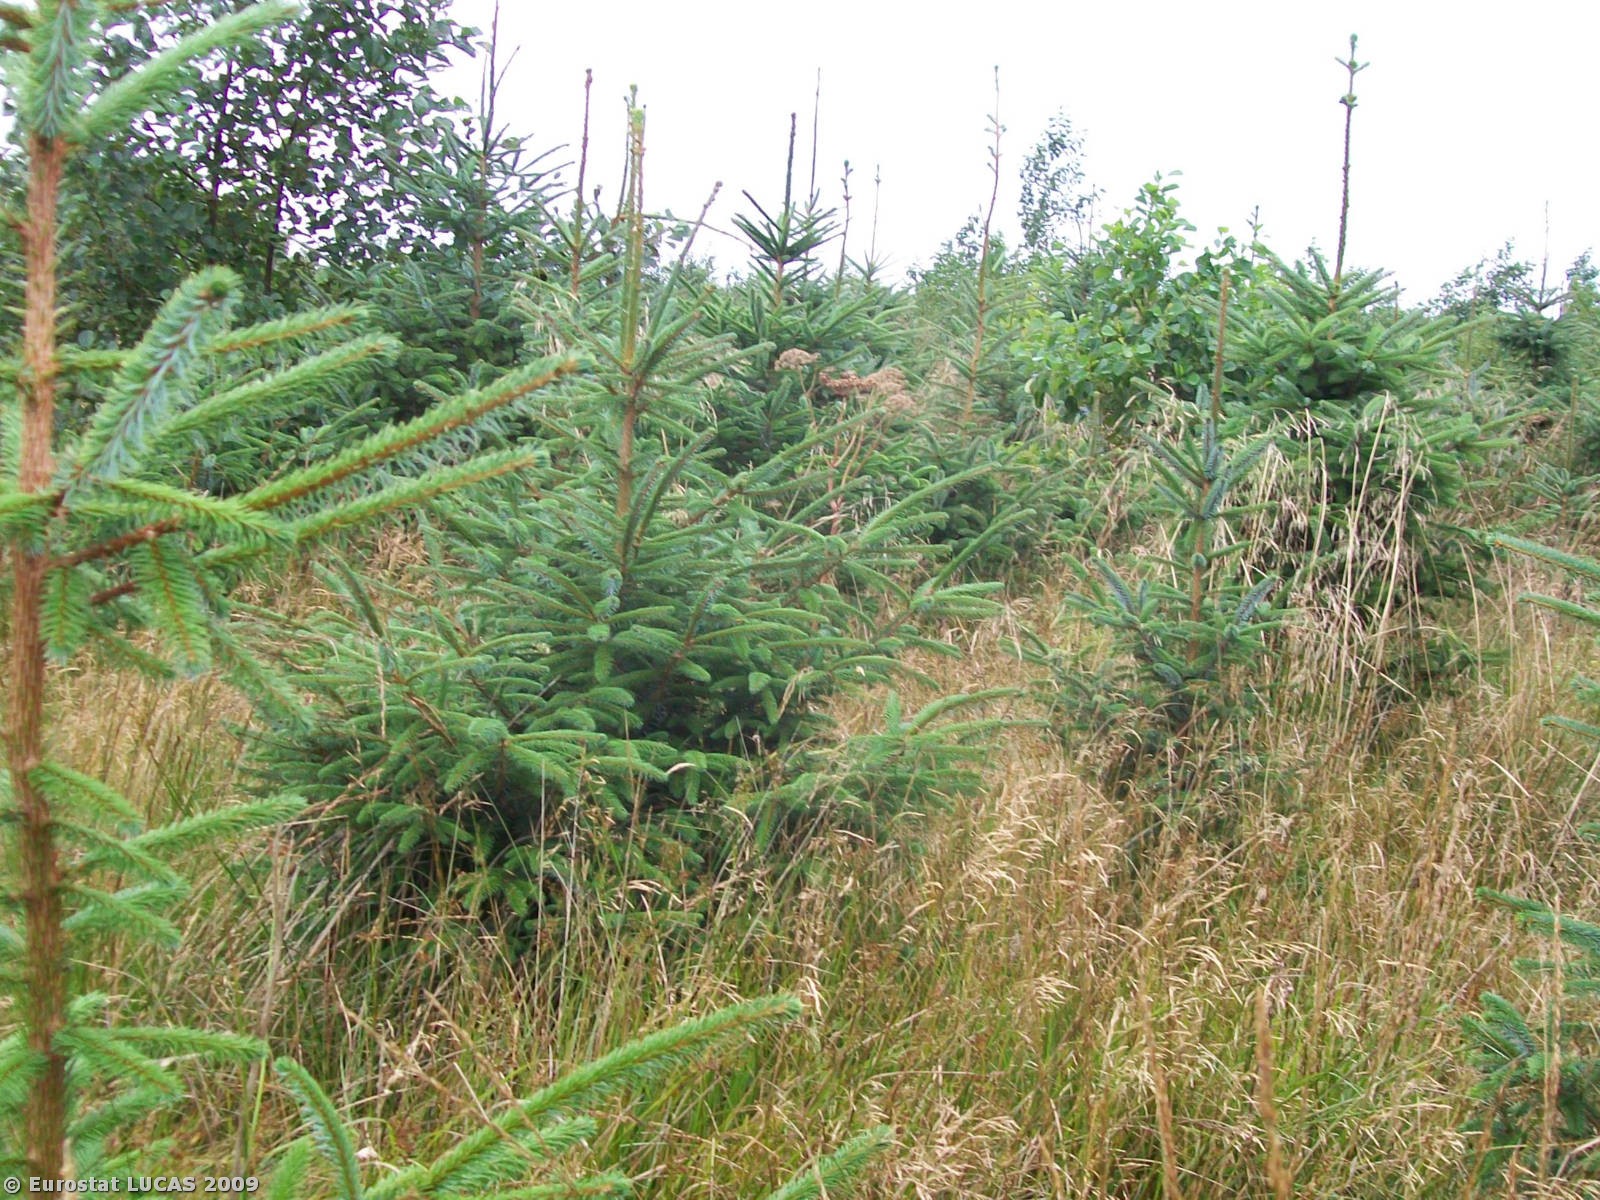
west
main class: Woodland
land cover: Mixed woodland
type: hemiboreal forest and nemoral coniferous forest and mixed broadleaved-coniferous forest
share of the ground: 25 - 50 %
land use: Forestry
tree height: > 5 m
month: September
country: GB
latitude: 55.4952
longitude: -4.2615
